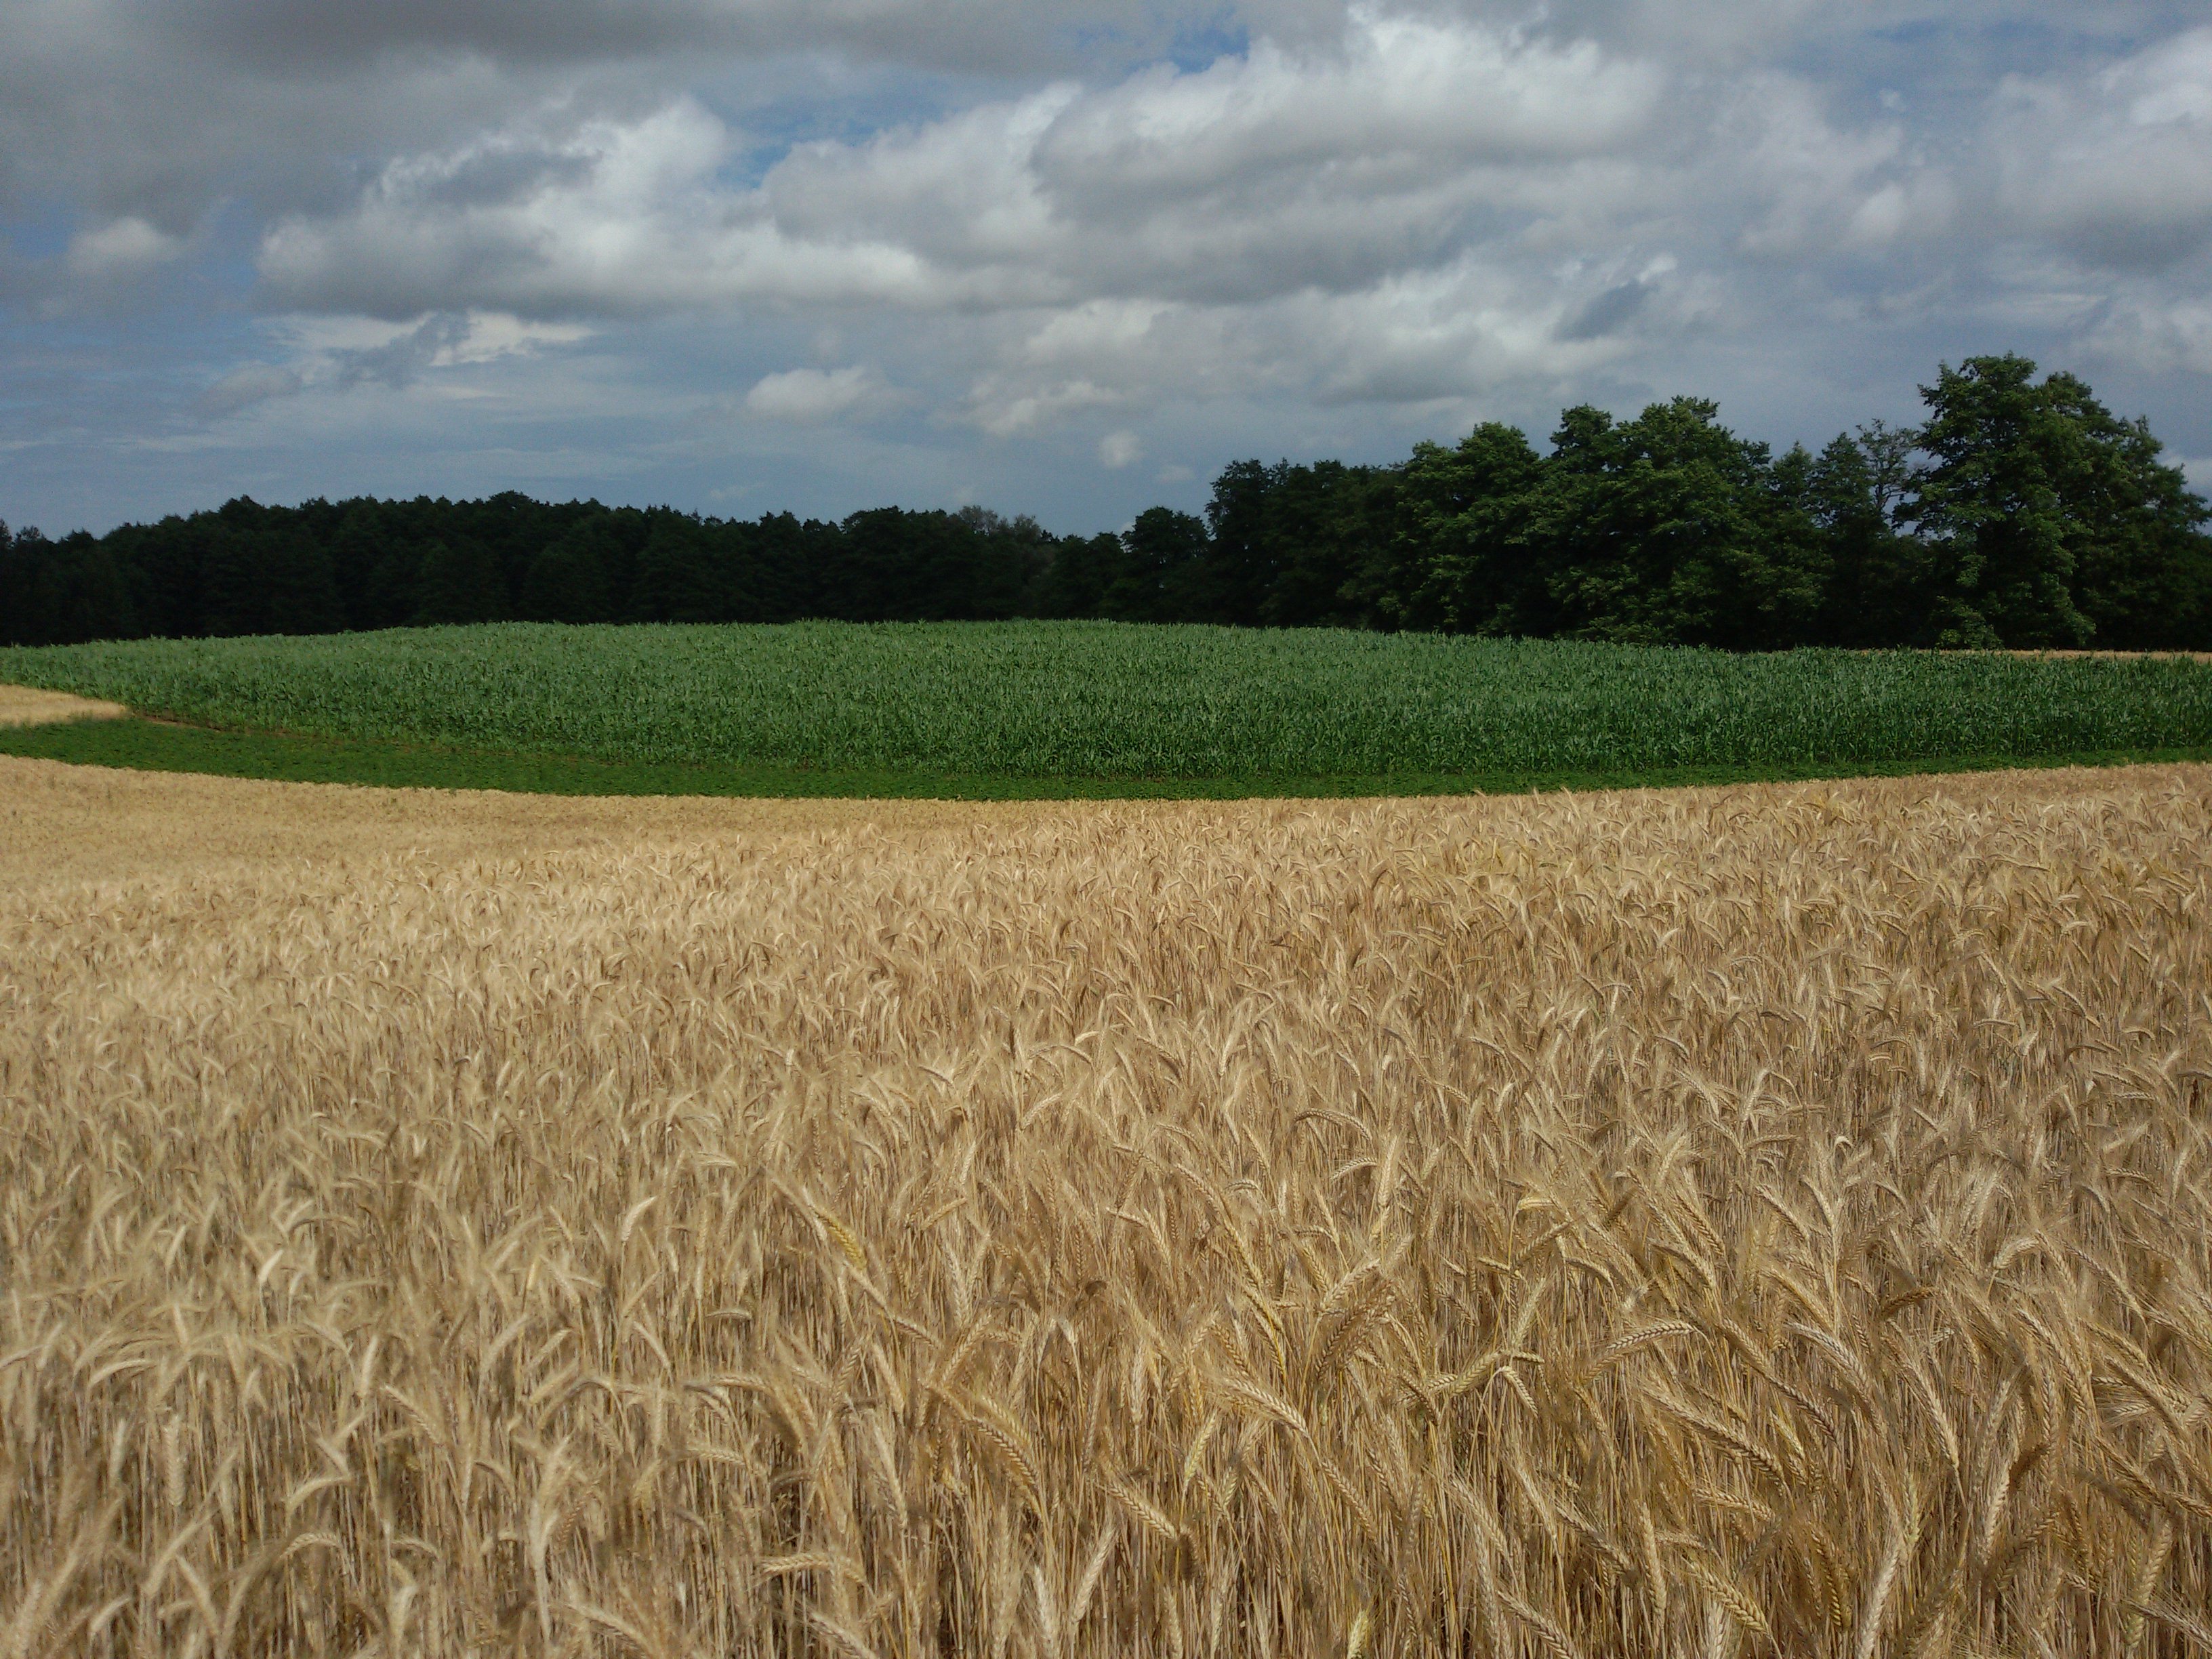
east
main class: Cropland
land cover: Triticale
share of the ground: > 75 %
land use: Agriculture (excluding fallow land and kitchen gardens)
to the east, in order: Triticale; Grass margins; Triticale; Potatoes; Maize; Grass margins; Tracks; Grassland without tree/shrub cover; Broadleaved woodland; Inland marshes; Inland fresh water bodies
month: July
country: PL
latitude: 52.8004
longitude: 17.6219
